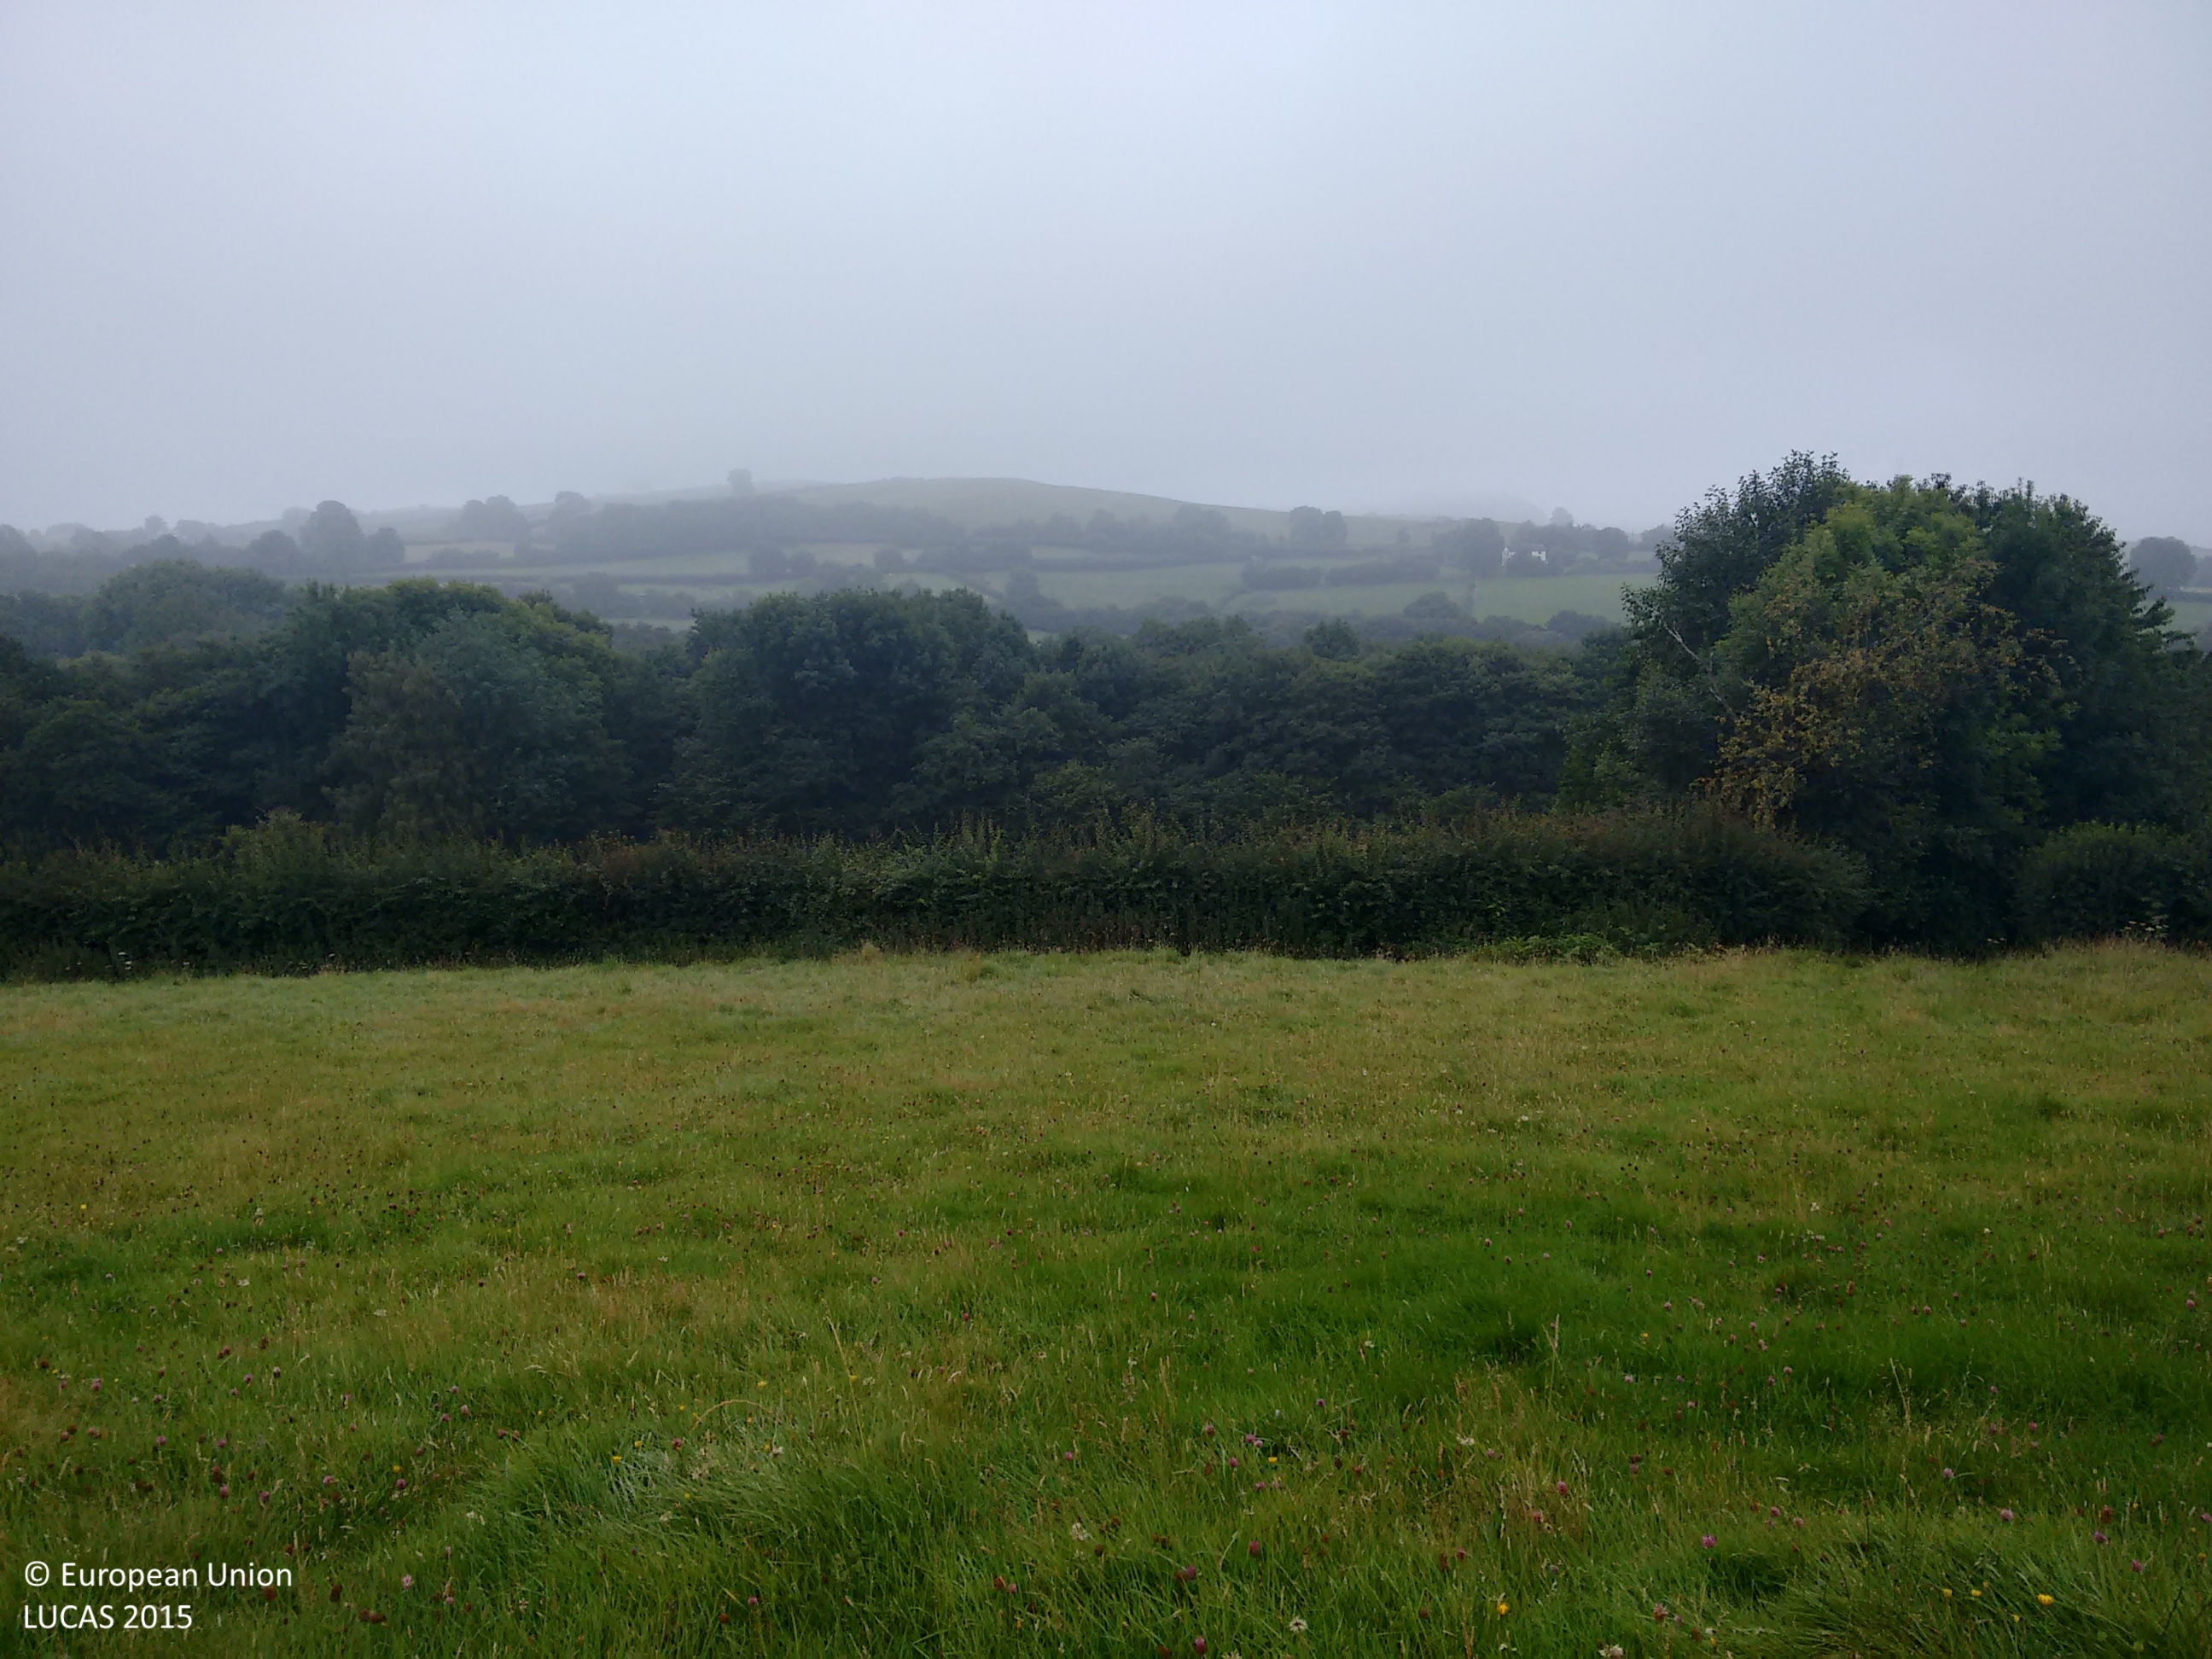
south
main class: Grassland
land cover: Grassland without tree/shrub cover
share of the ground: > 75 %
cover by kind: herbaceous plants 100 %
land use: Agriculture (excluding fallow land and kitchen gardens)
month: September
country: GB
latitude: 52.1335
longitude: -3.1533
